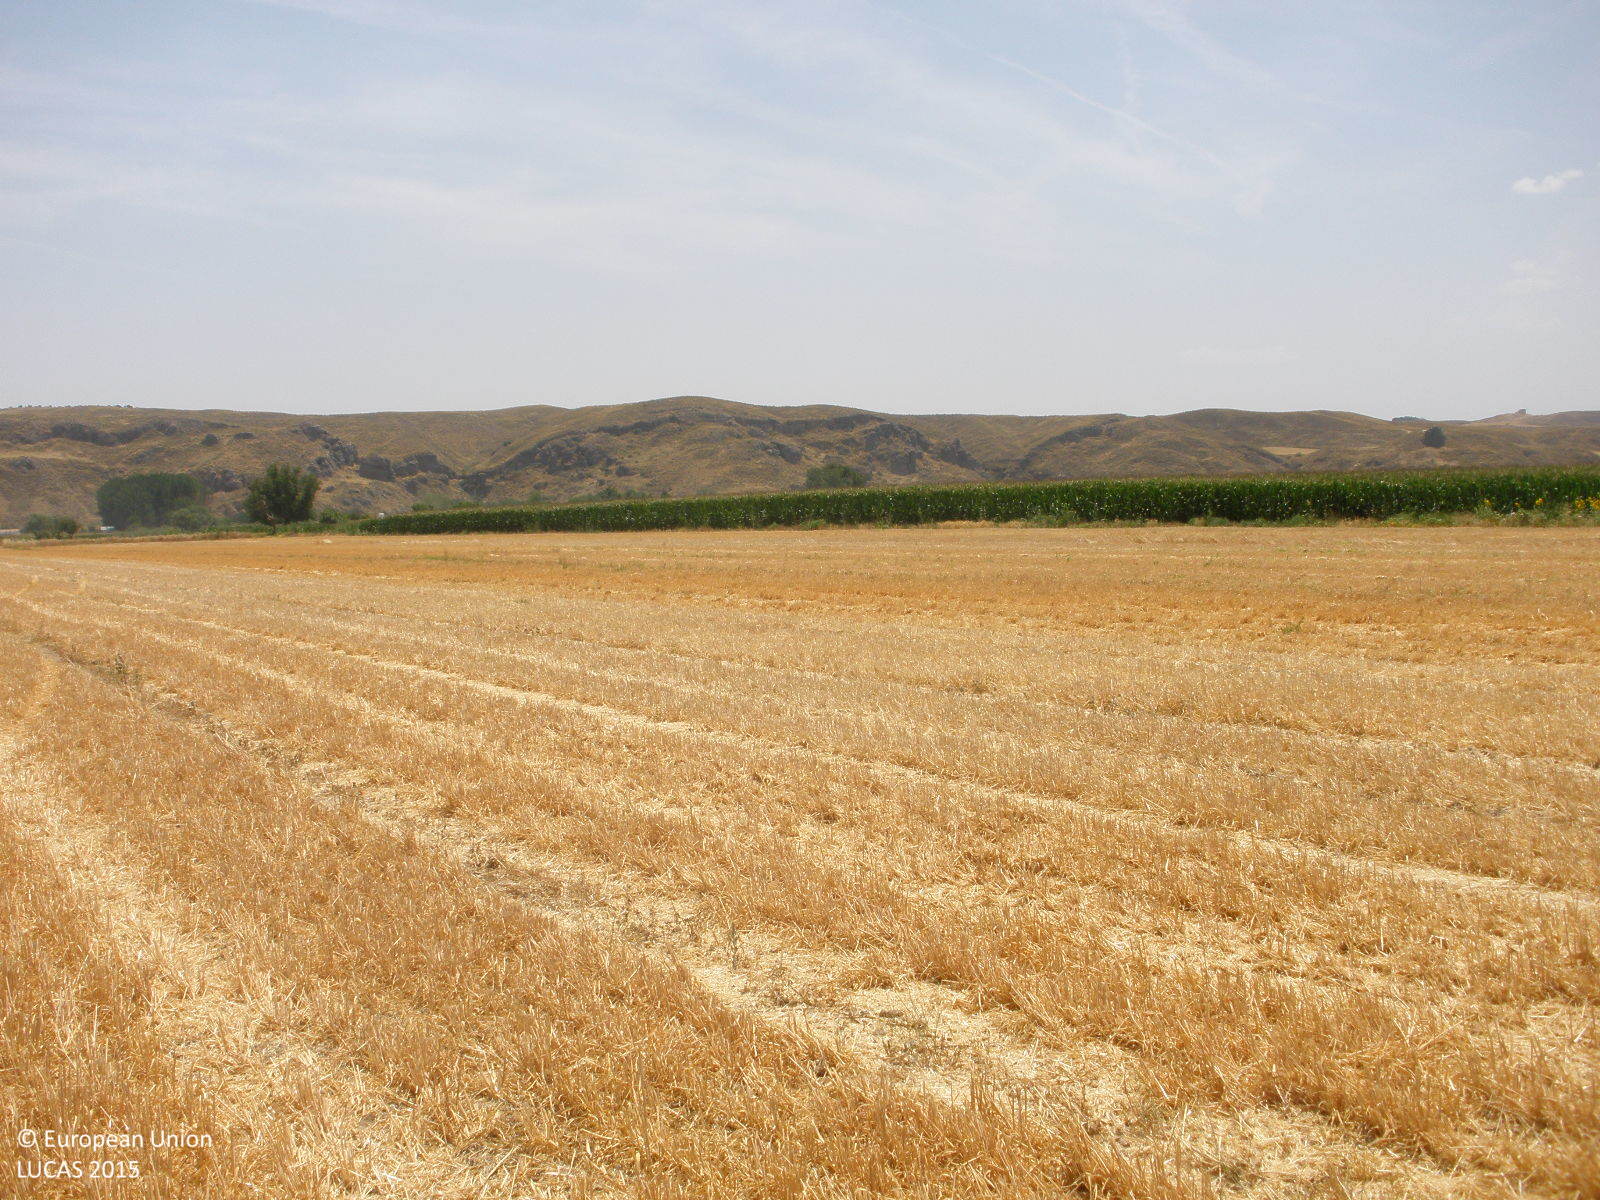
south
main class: Cropland
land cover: Barley
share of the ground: < 10 %
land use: Agriculture (excluding fallow land and kitchen gardens)
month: July
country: ES
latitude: 40.1509
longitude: -3.5200
